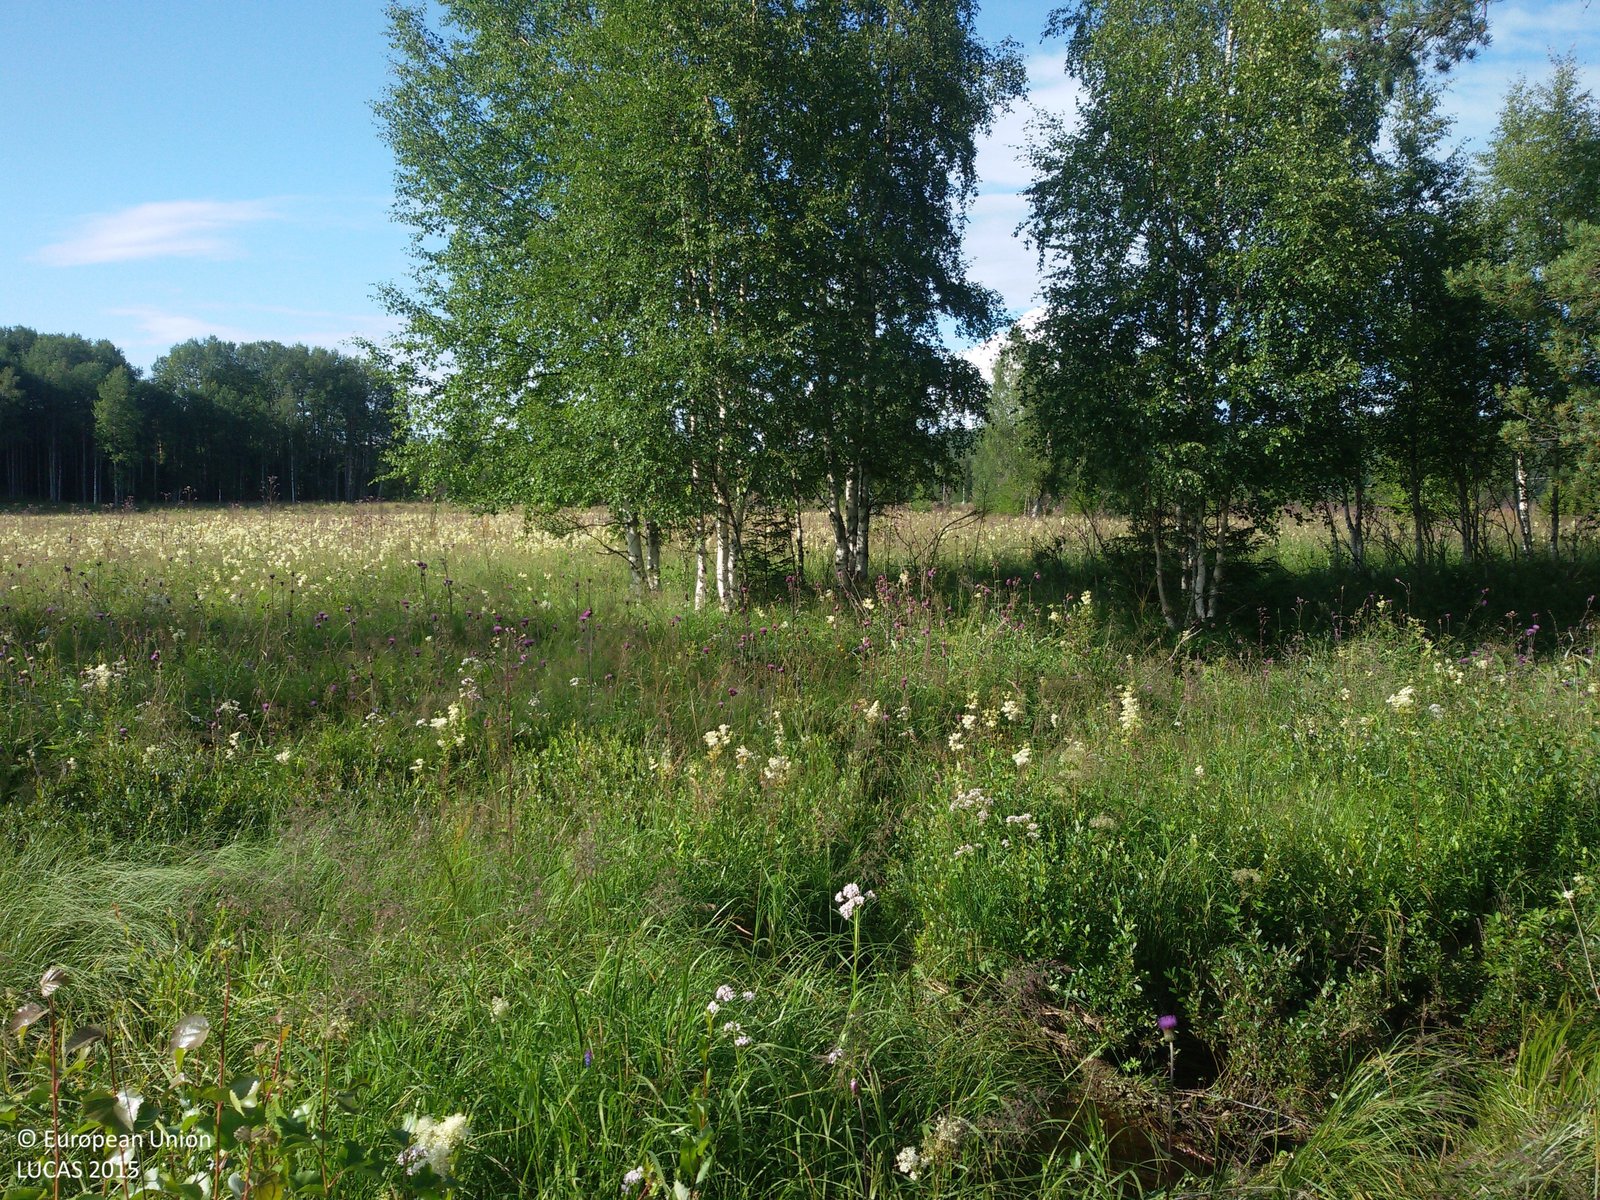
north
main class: Grassland
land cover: Grassland without tree/shrub cover
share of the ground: > 75 %
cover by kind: herbaceous plants 100 %
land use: Agriculture (excluding fallow land and kitchen gardens)
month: July
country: SE
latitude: 60.6341
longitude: 14.9781
